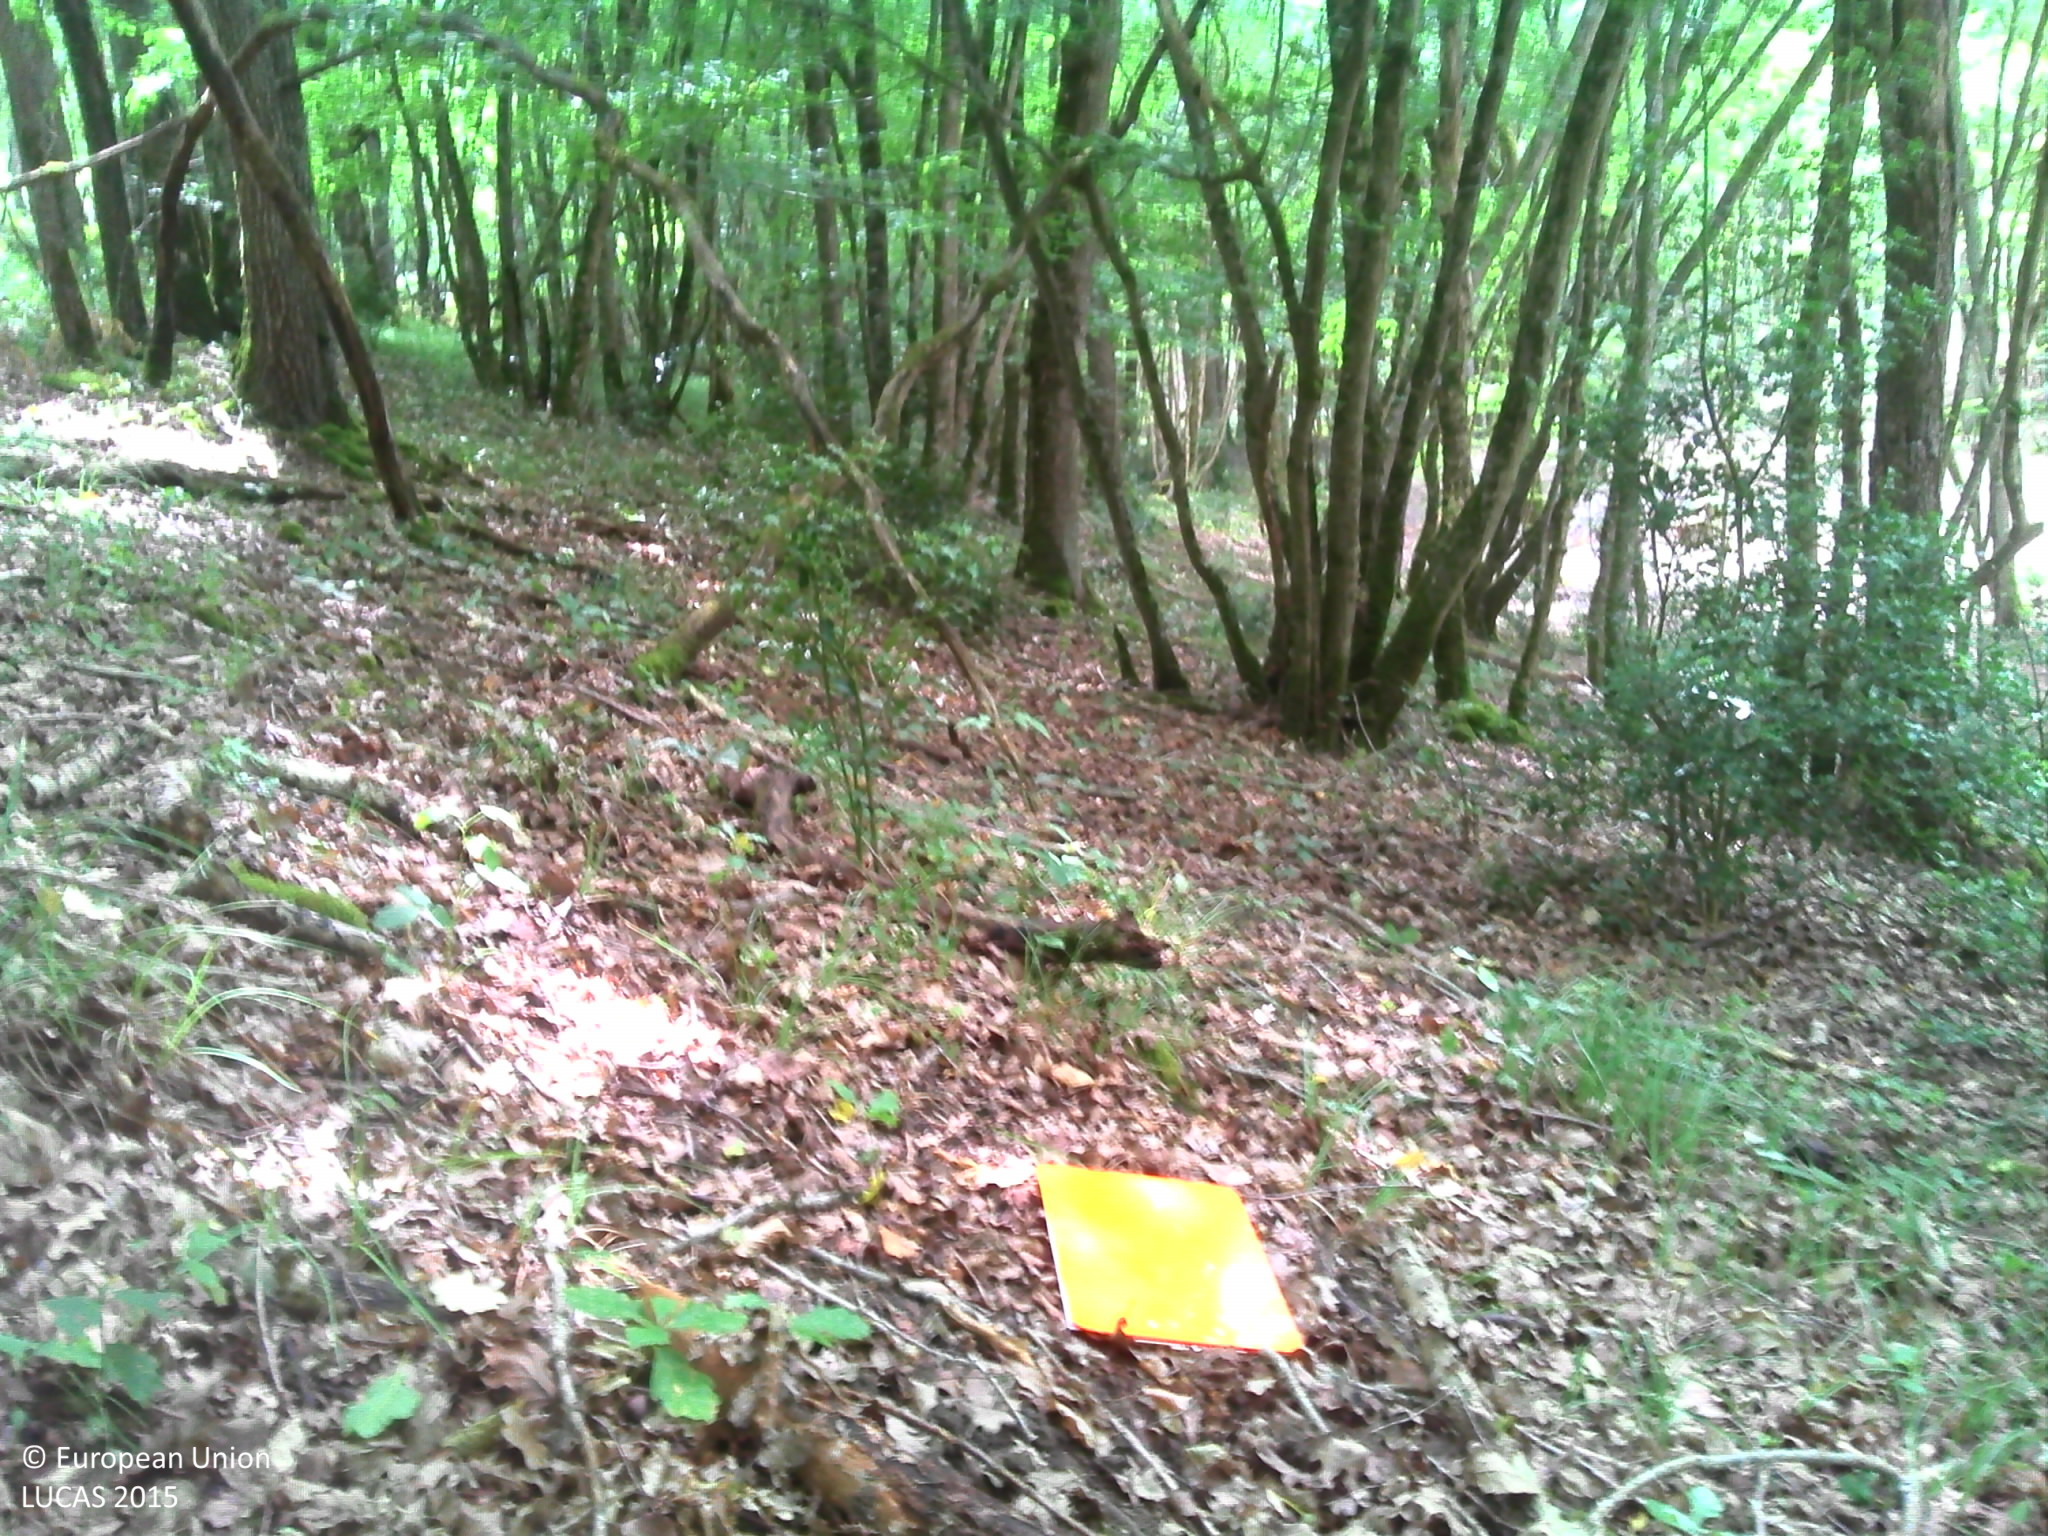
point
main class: Woodland
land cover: Broadleaved woodland
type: mesophytic deciduous forest
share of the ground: > 75 %
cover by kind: broadleaved forest trees 85 %, shrubs 5 %, herbaceous plants 5 %, lichens and mosses 5 %
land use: Forestry
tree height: > 5 m
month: July
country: FR
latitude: 46.8970
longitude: 0.8083
